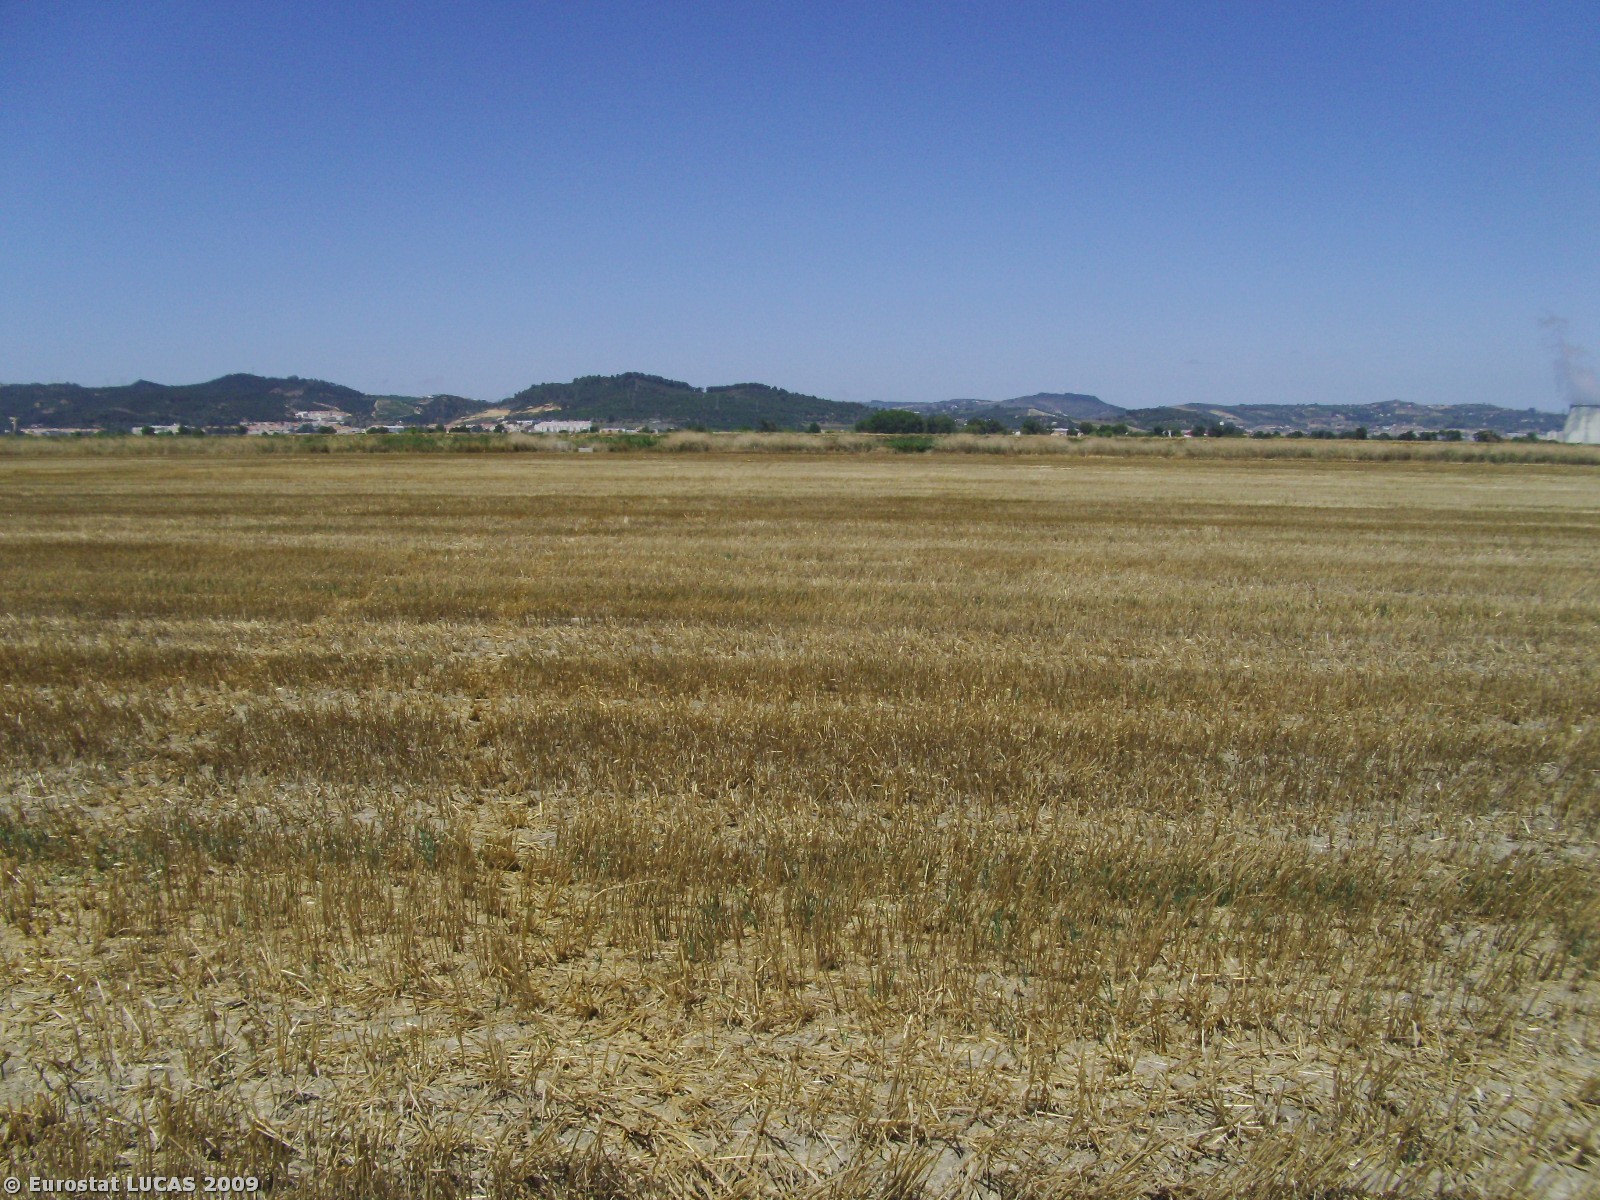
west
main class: Cropland
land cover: Common wheat
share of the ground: > 75 %
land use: Agriculture (excluding fallow land and kitchen gardens)
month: July
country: PT
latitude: 38.9981
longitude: -8.9300
